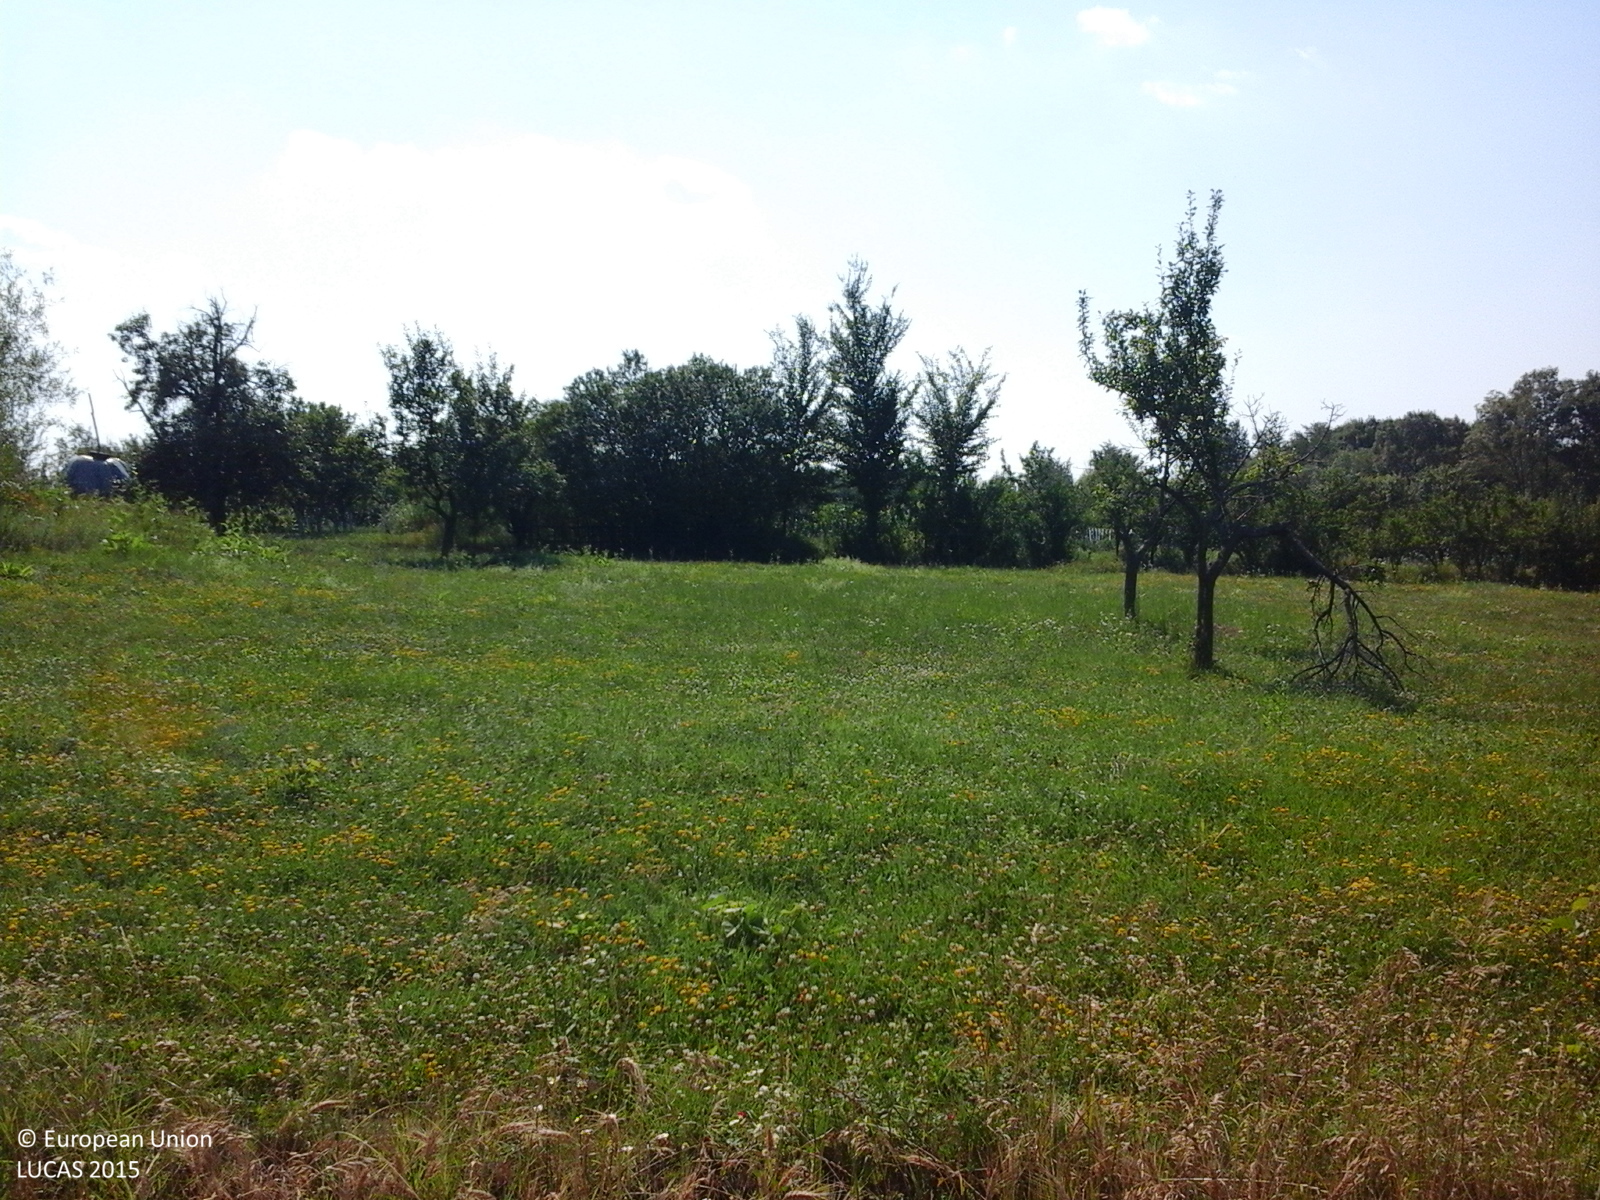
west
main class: Cropland
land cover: Common wheat
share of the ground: > 75 %
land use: Agriculture (excluding fallow land and kitchen gardens)
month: July
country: RO
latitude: 44.7164
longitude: 24.6307
